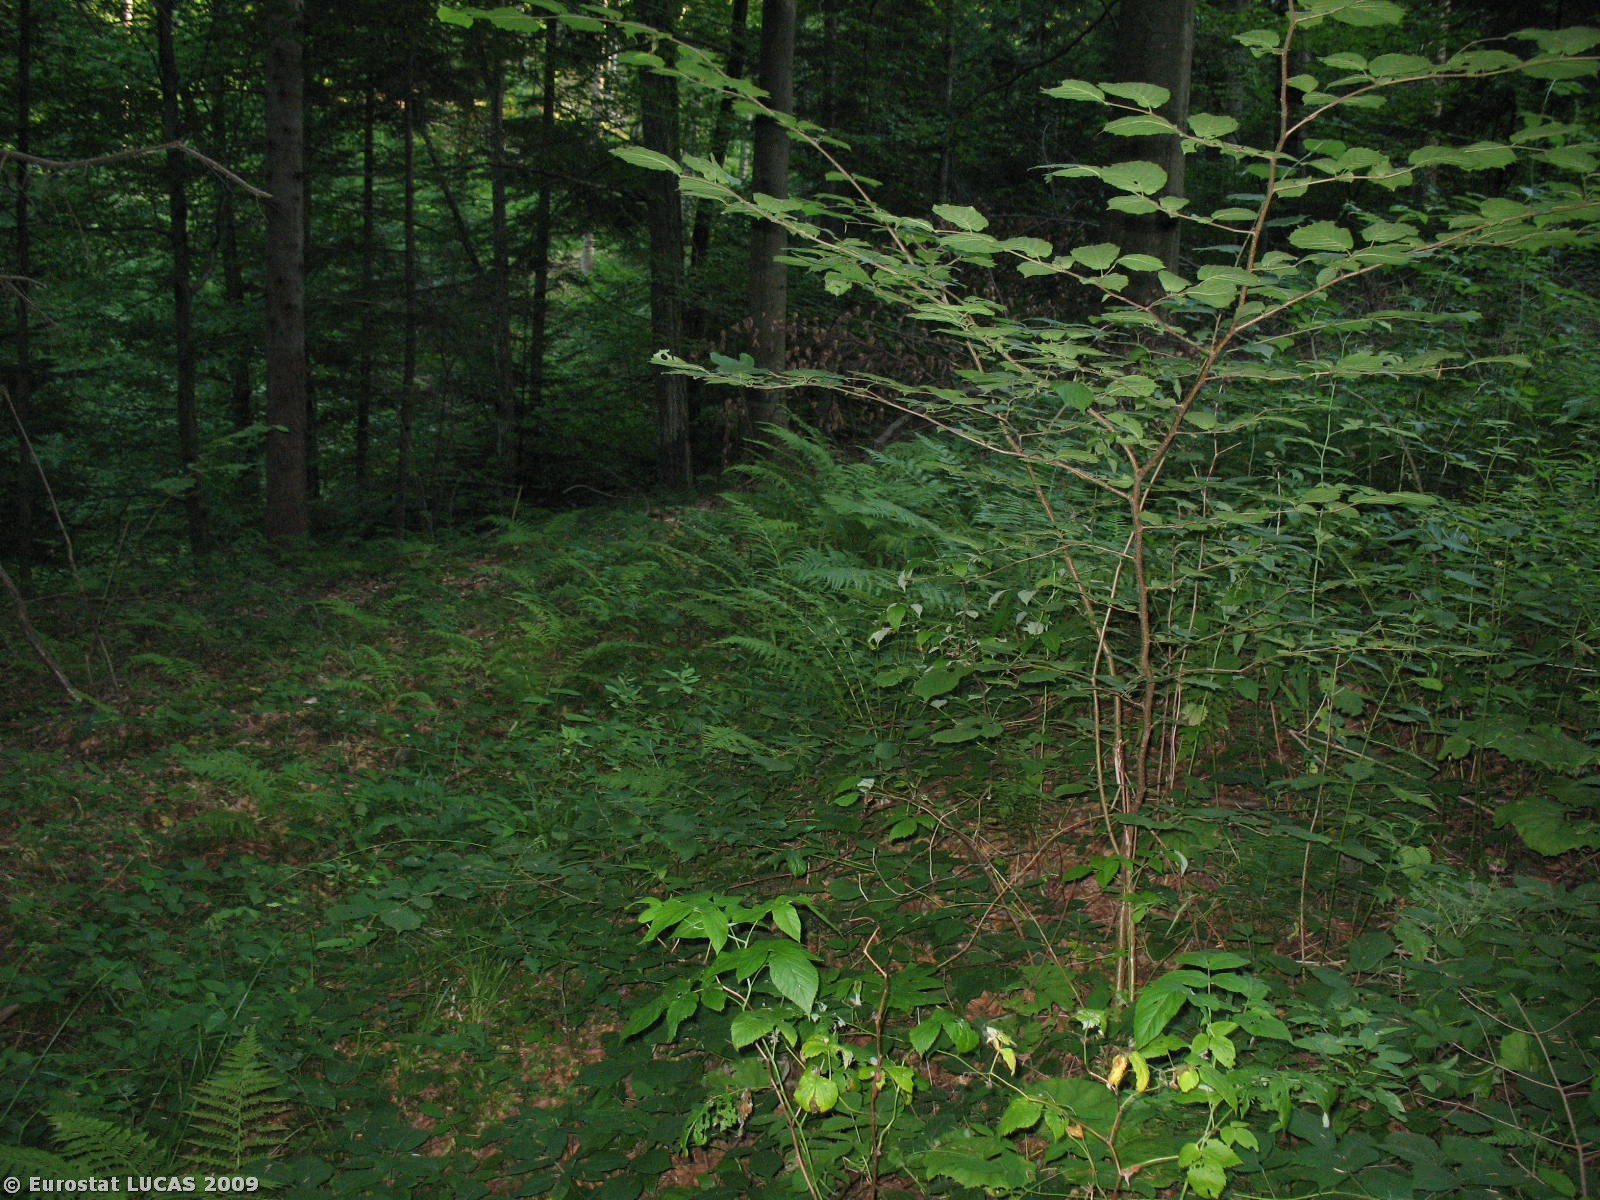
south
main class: Woodland
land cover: Mixed woodland
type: hemiboreal forest and nemoral coniferous forest and mixed broadleaved-coniferous forest
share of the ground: > 75 %
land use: Forestry
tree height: > 5 m
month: August
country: PL
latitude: 49.7528
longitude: 22.2896
